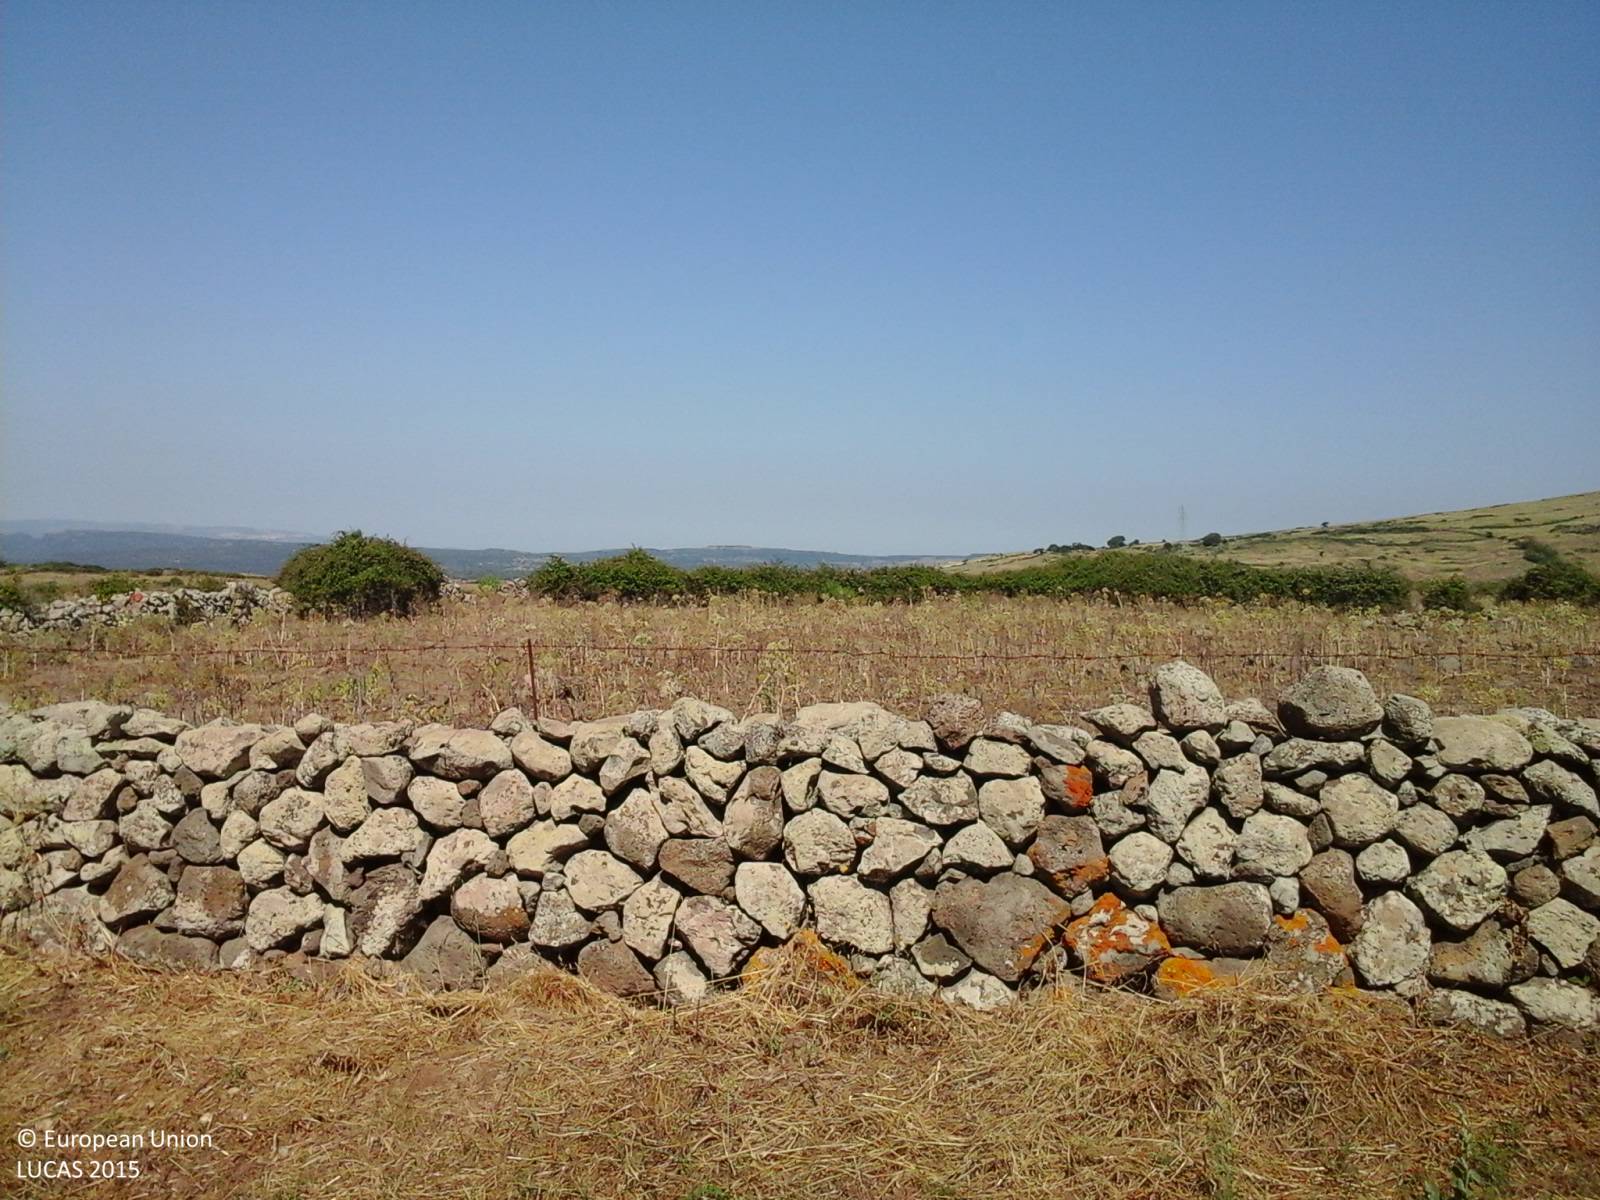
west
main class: Grassland
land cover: Grassland without tree/shrub cover
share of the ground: > 75 %
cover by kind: herbaceous plants 100 %
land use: Agriculture (excluding fallow land and kitchen gardens)
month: June
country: IT
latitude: 40.5308
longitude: 8.7431
